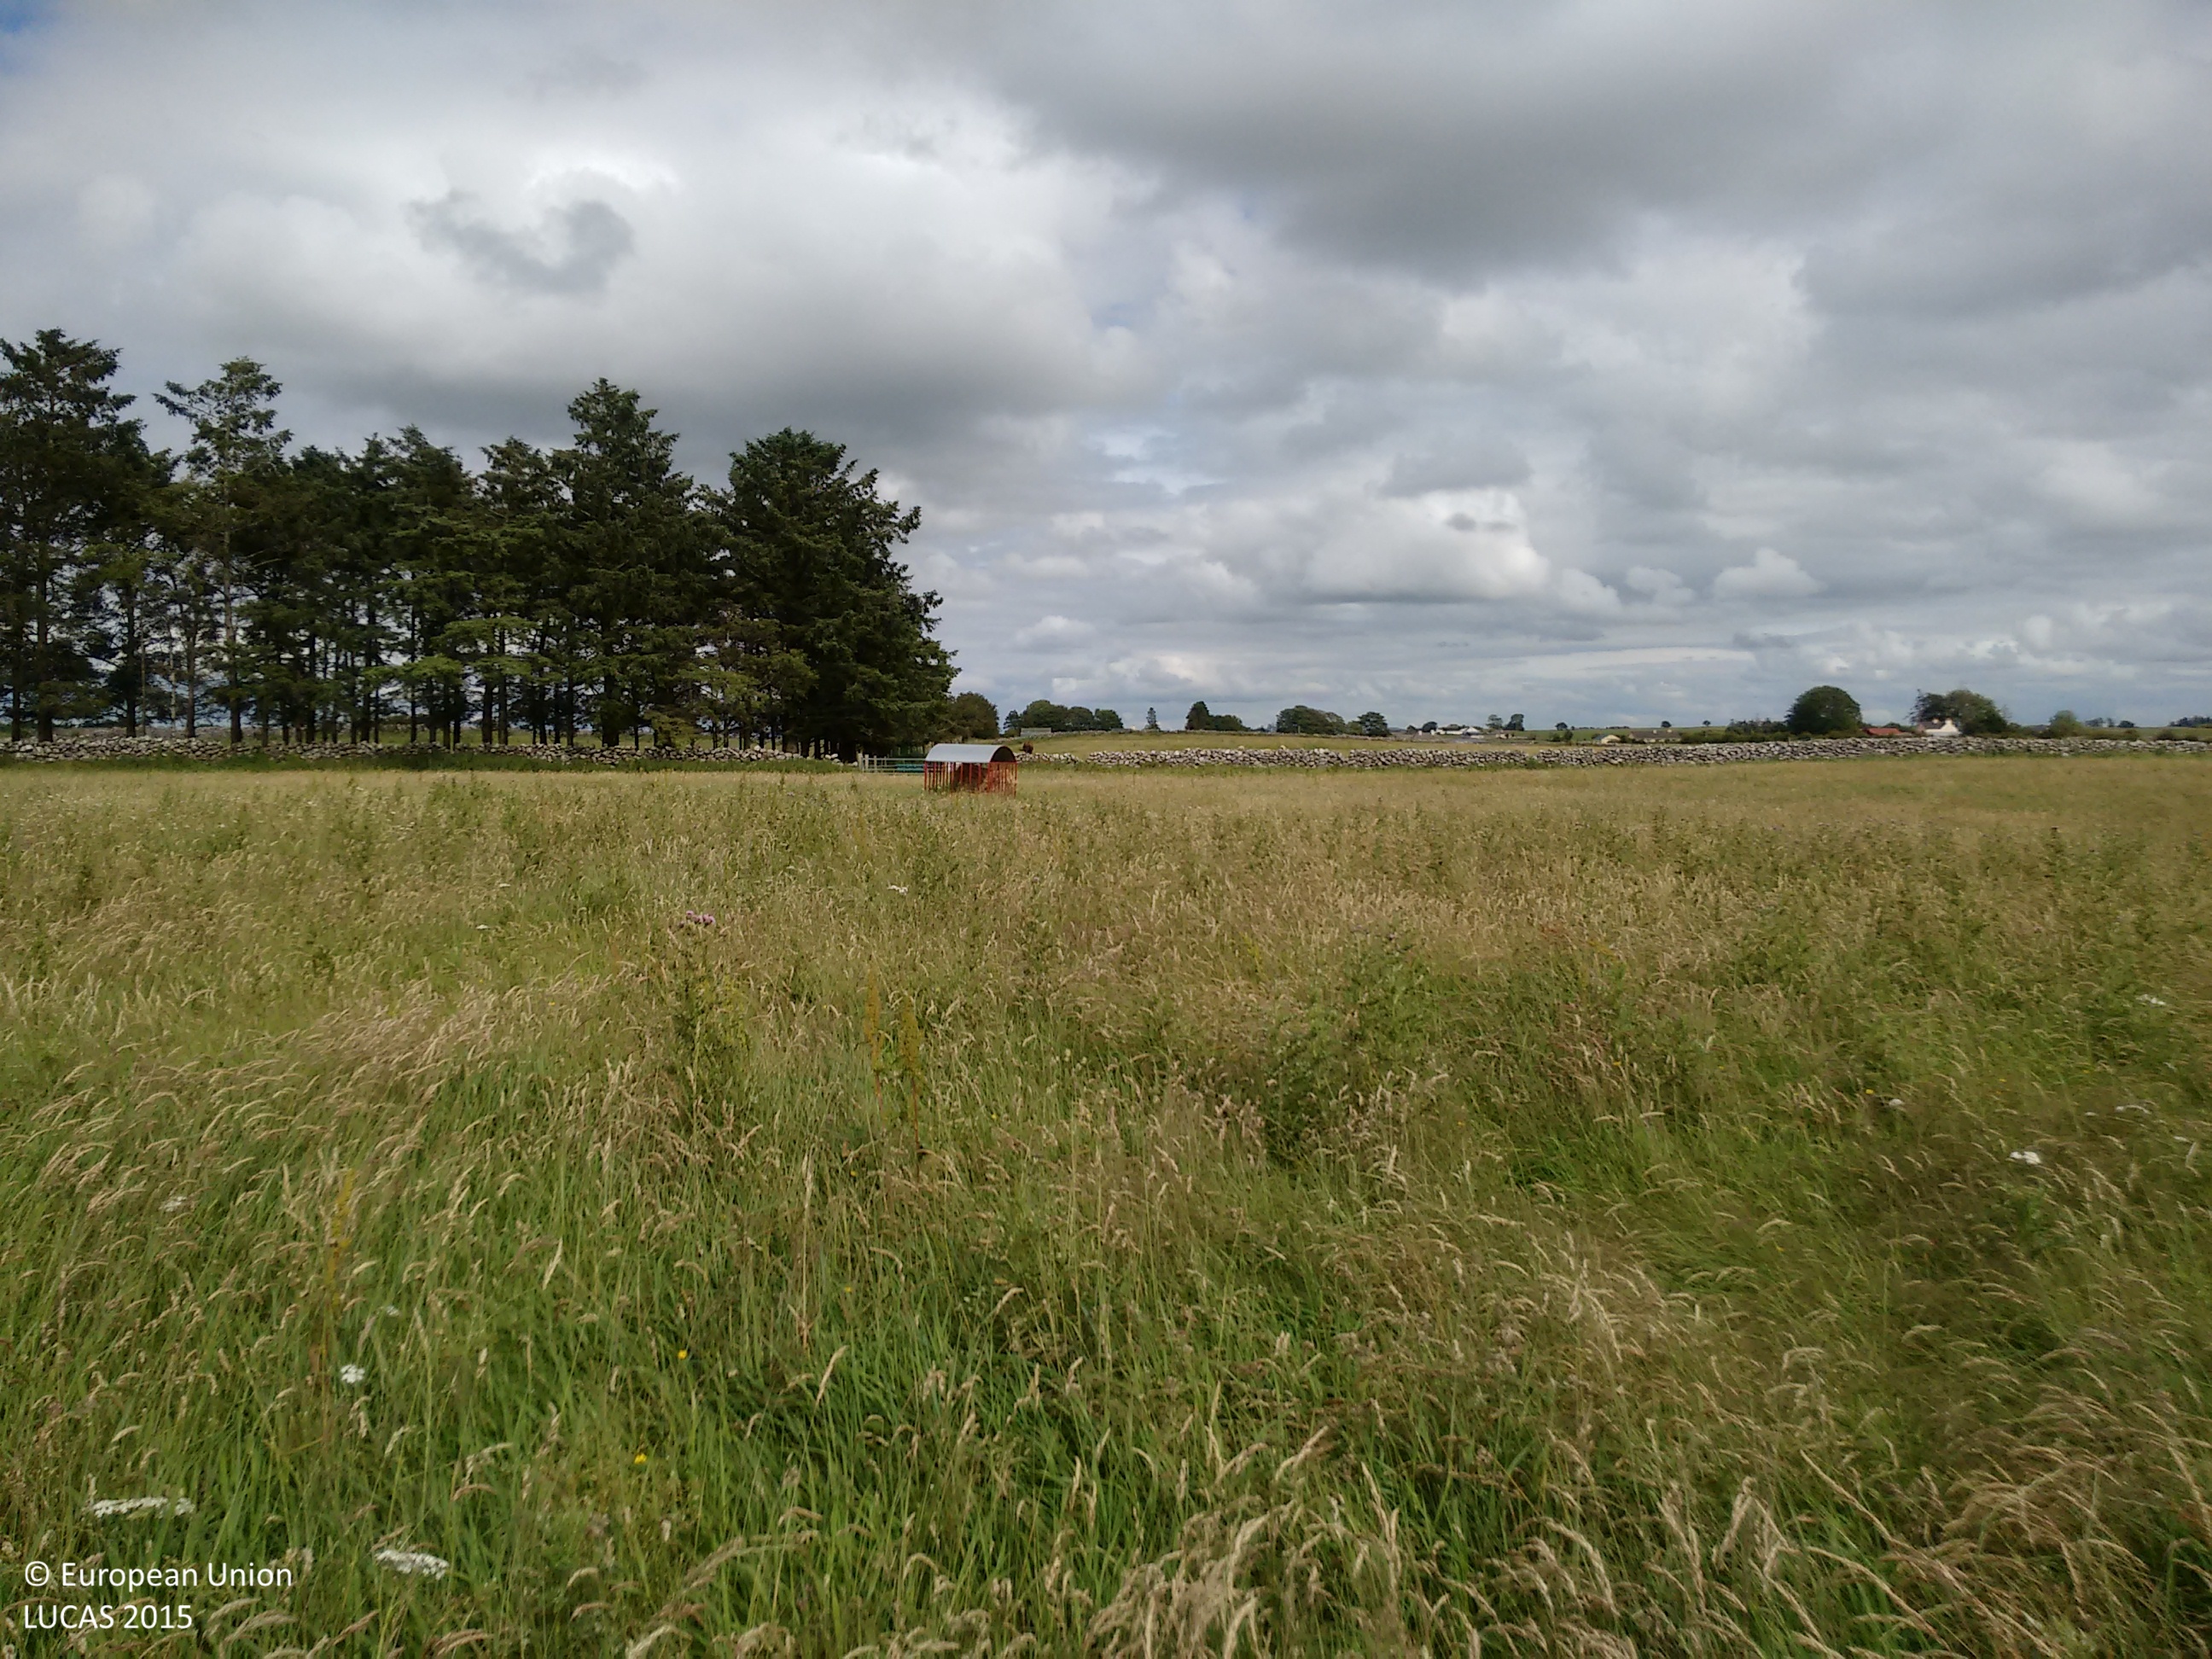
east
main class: Grassland
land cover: Grassland without tree/shrub cover
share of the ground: > 75 %
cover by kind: herbaceous plants 100 %
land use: Agriculture (excluding fallow land and kitchen gardens)
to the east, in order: Grassland without tree/shrub cover; Dry stone walls; Fences; Grassland without tree/shrub cover; Dry stone walls; Grassland without tree/shrub cover
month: July
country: IE
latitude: 53.6146
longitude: -9.1277
